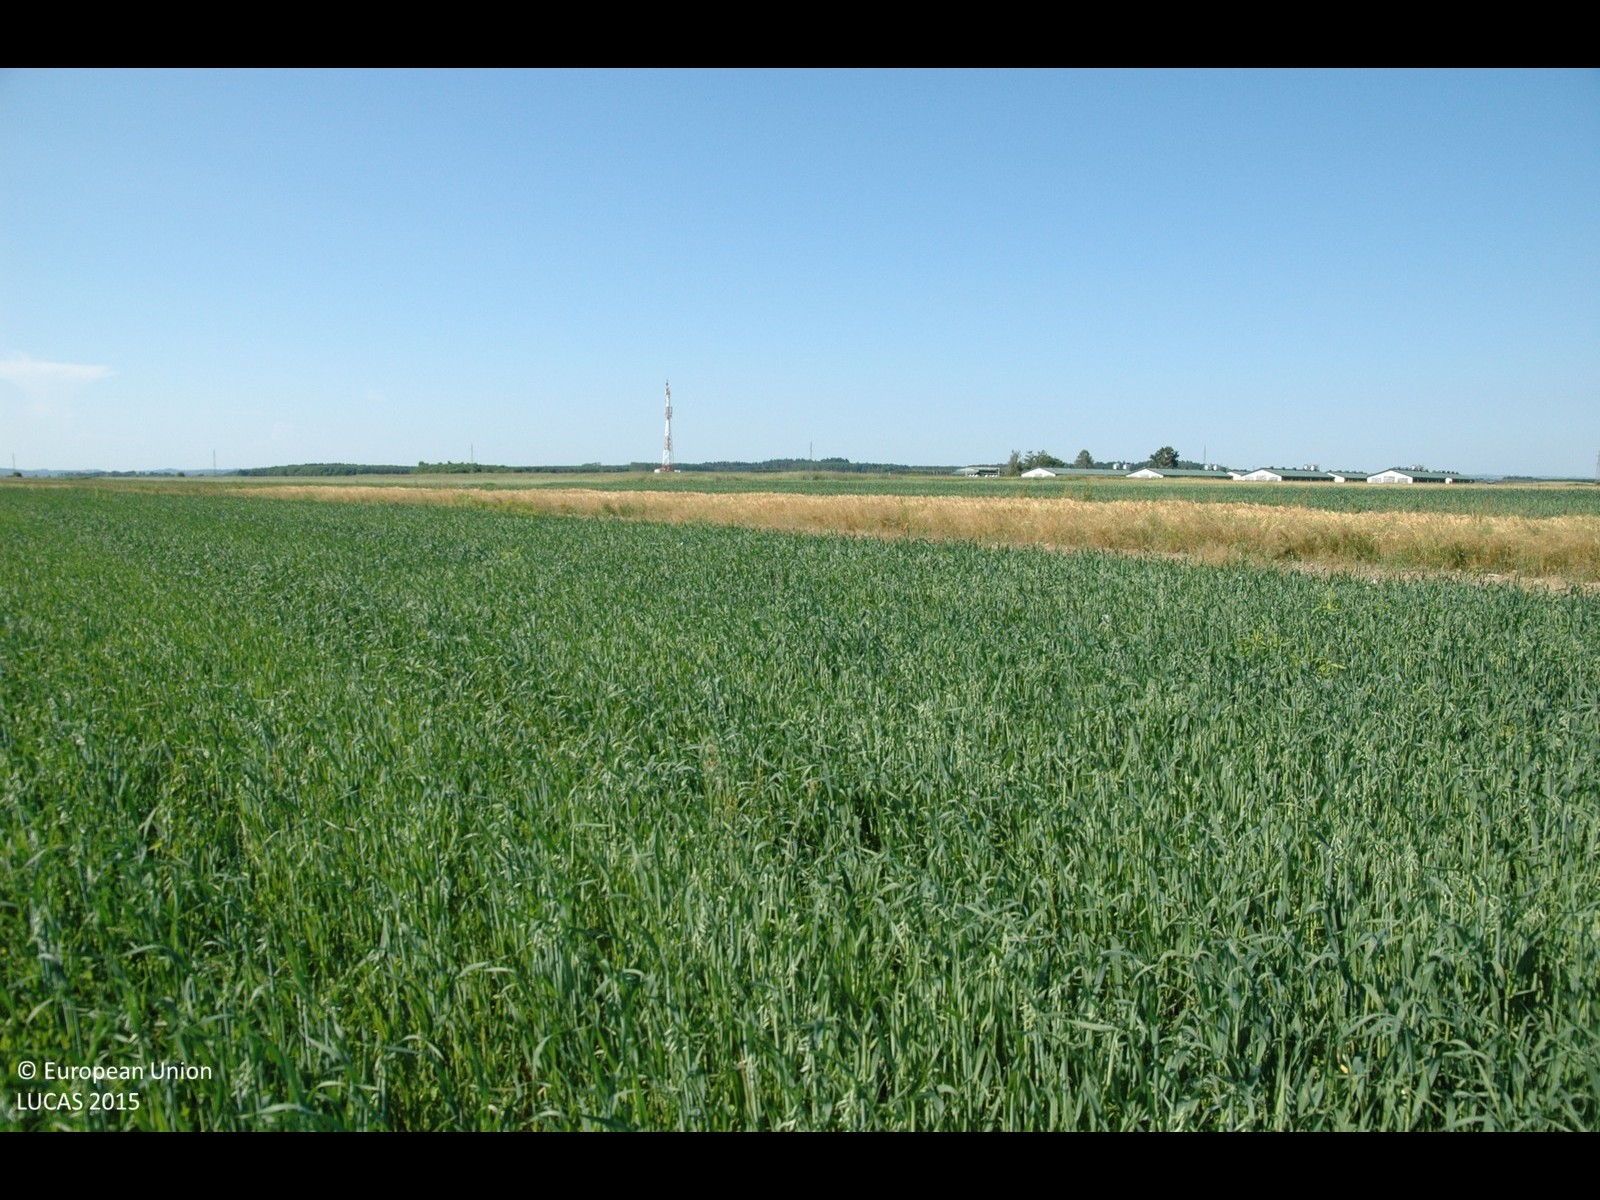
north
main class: Cropland
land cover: Oats
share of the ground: > 75 %
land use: Agriculture (excluding fallow land and kitchen gardens)
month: June
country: HR
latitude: 46.3162
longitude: 16.1944
